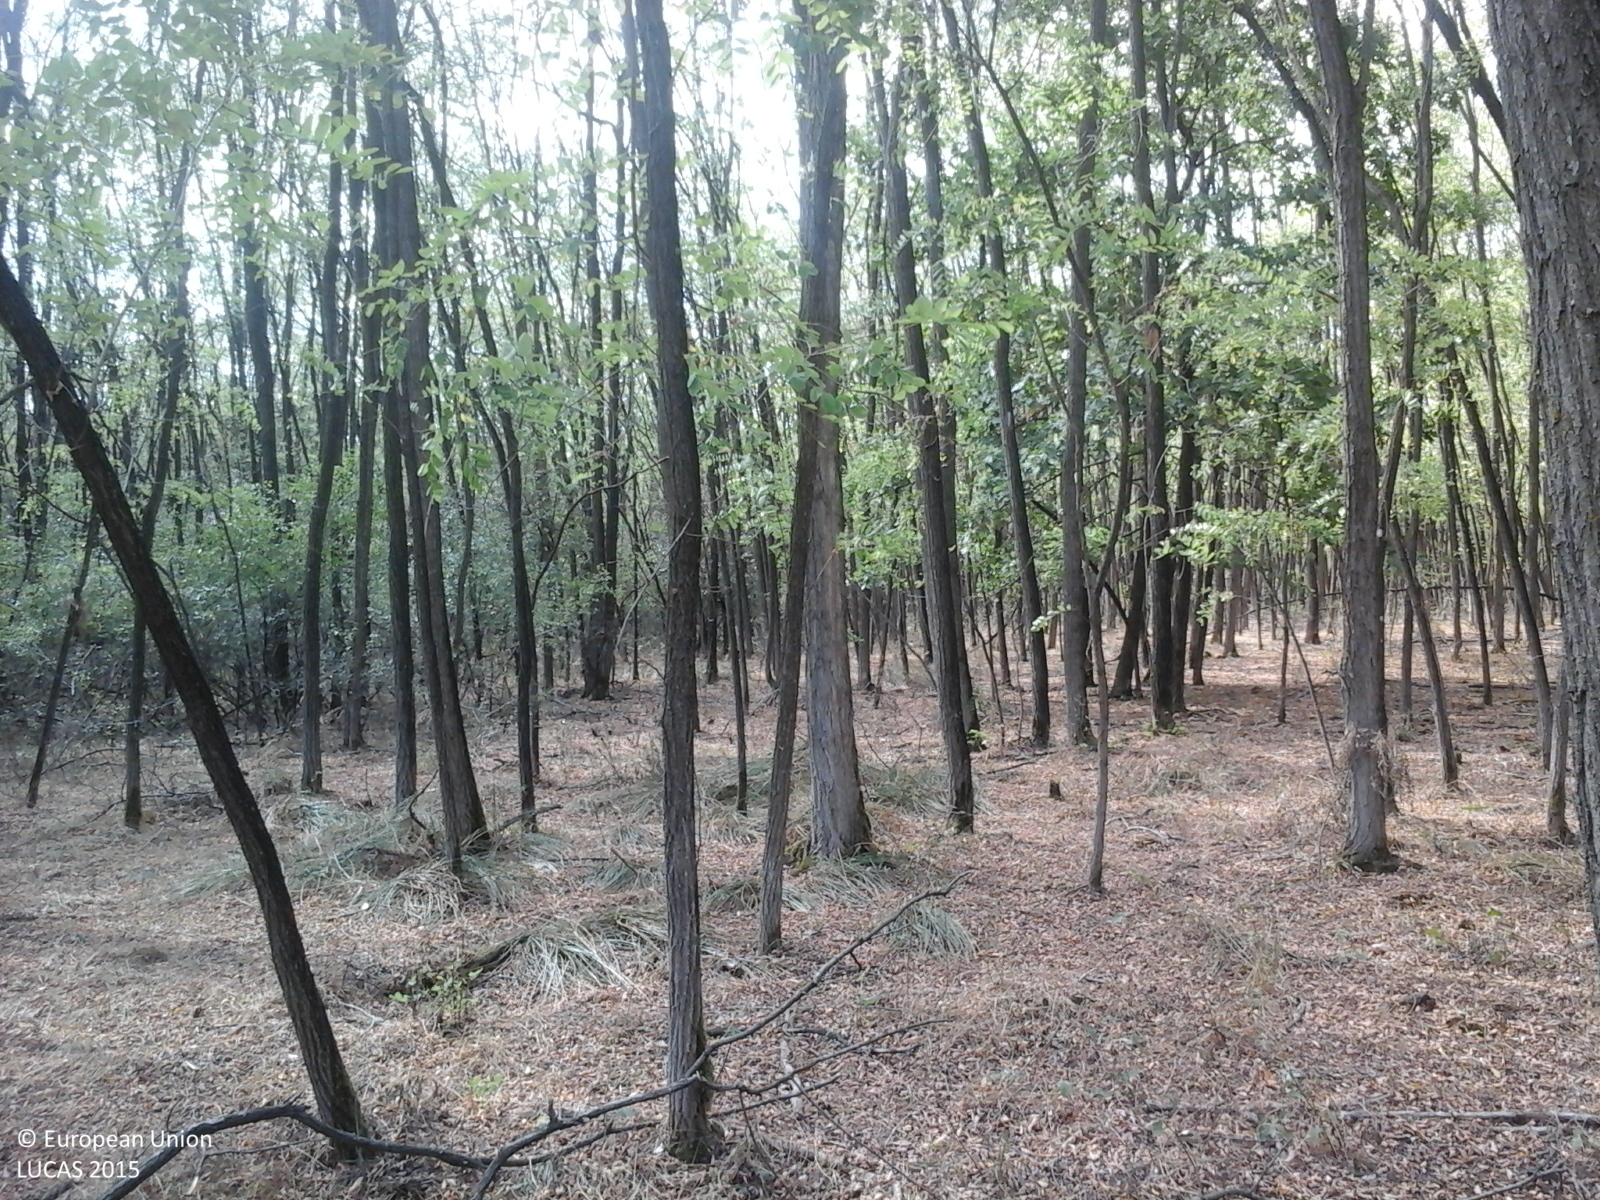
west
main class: Woodland
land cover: Broadleaved woodland
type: exotic forest
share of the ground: > 75 %
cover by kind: broadleaved forest trees 100 %
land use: Forestry
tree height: > 5 m
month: September
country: RO
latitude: 47.6397
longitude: 22.9360
